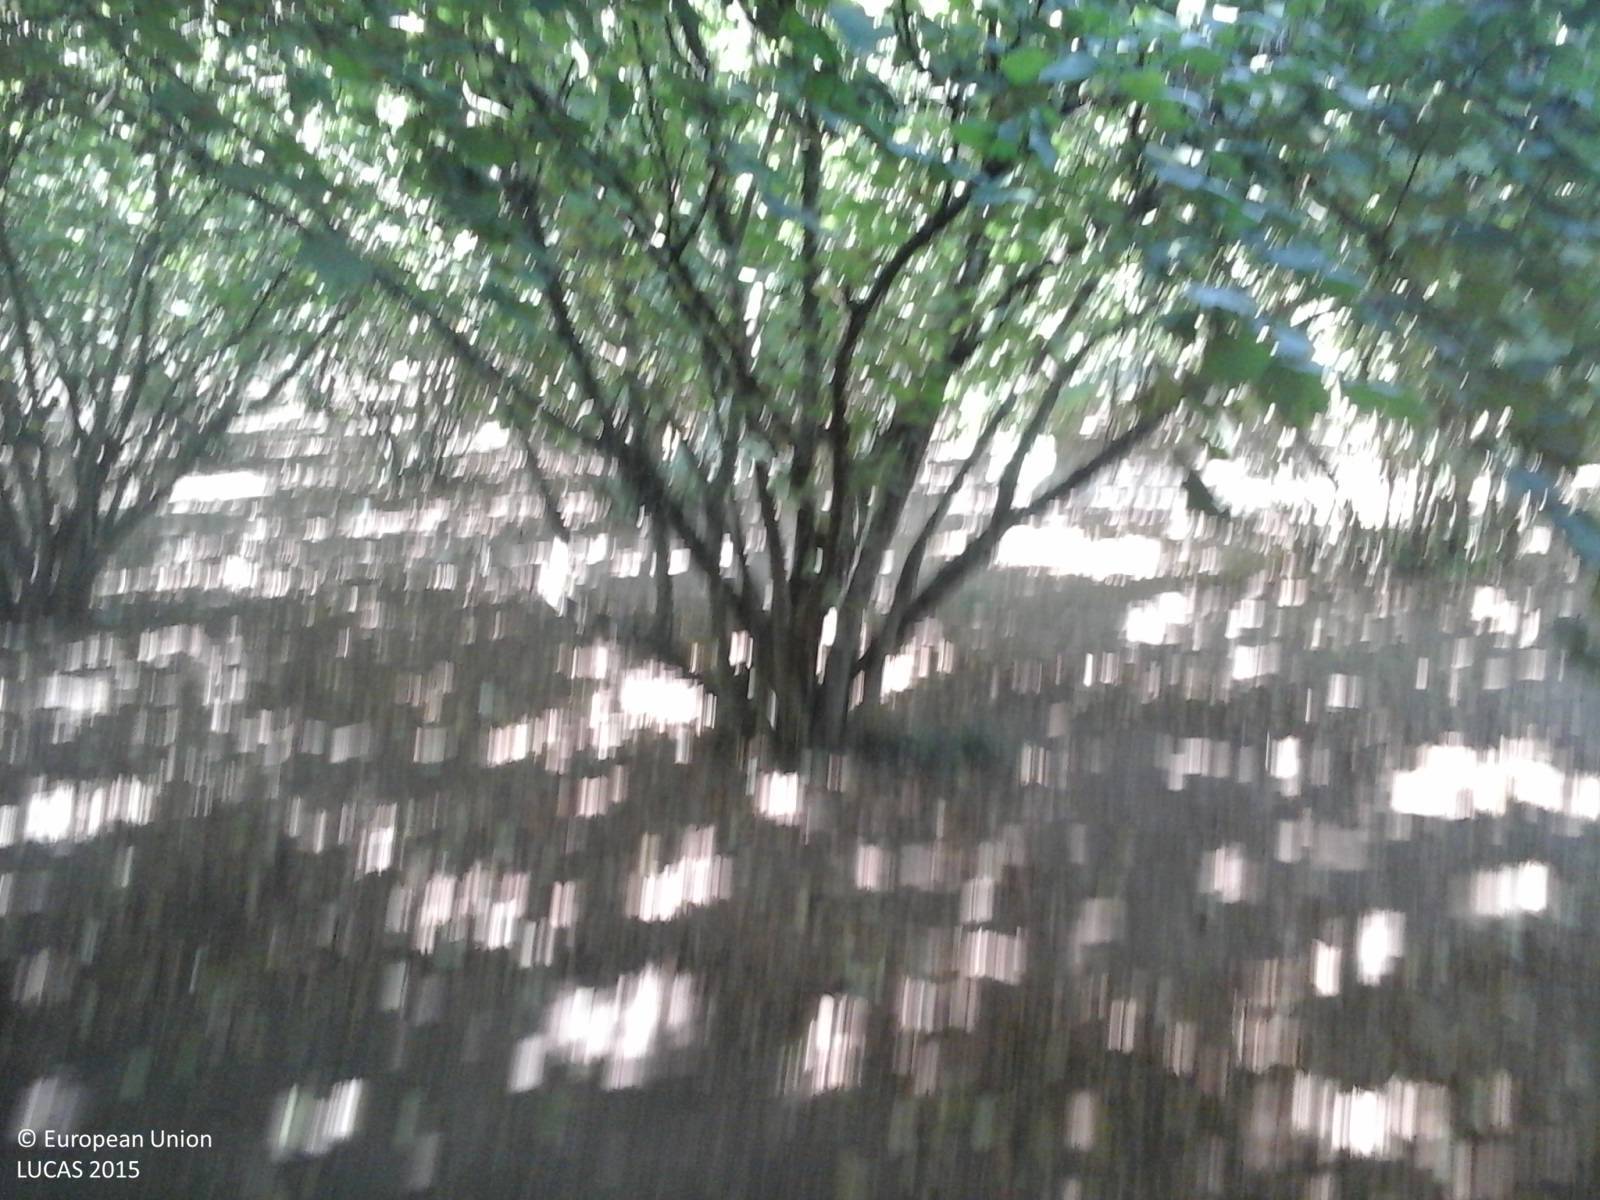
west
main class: Cropland
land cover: Nuts trees
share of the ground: > 75 %
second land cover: Other bare soil
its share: > 75 %
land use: Agriculture (excluding fallow land and kitchen gardens)
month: September
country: IT
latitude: 42.3752
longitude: 12.2875
